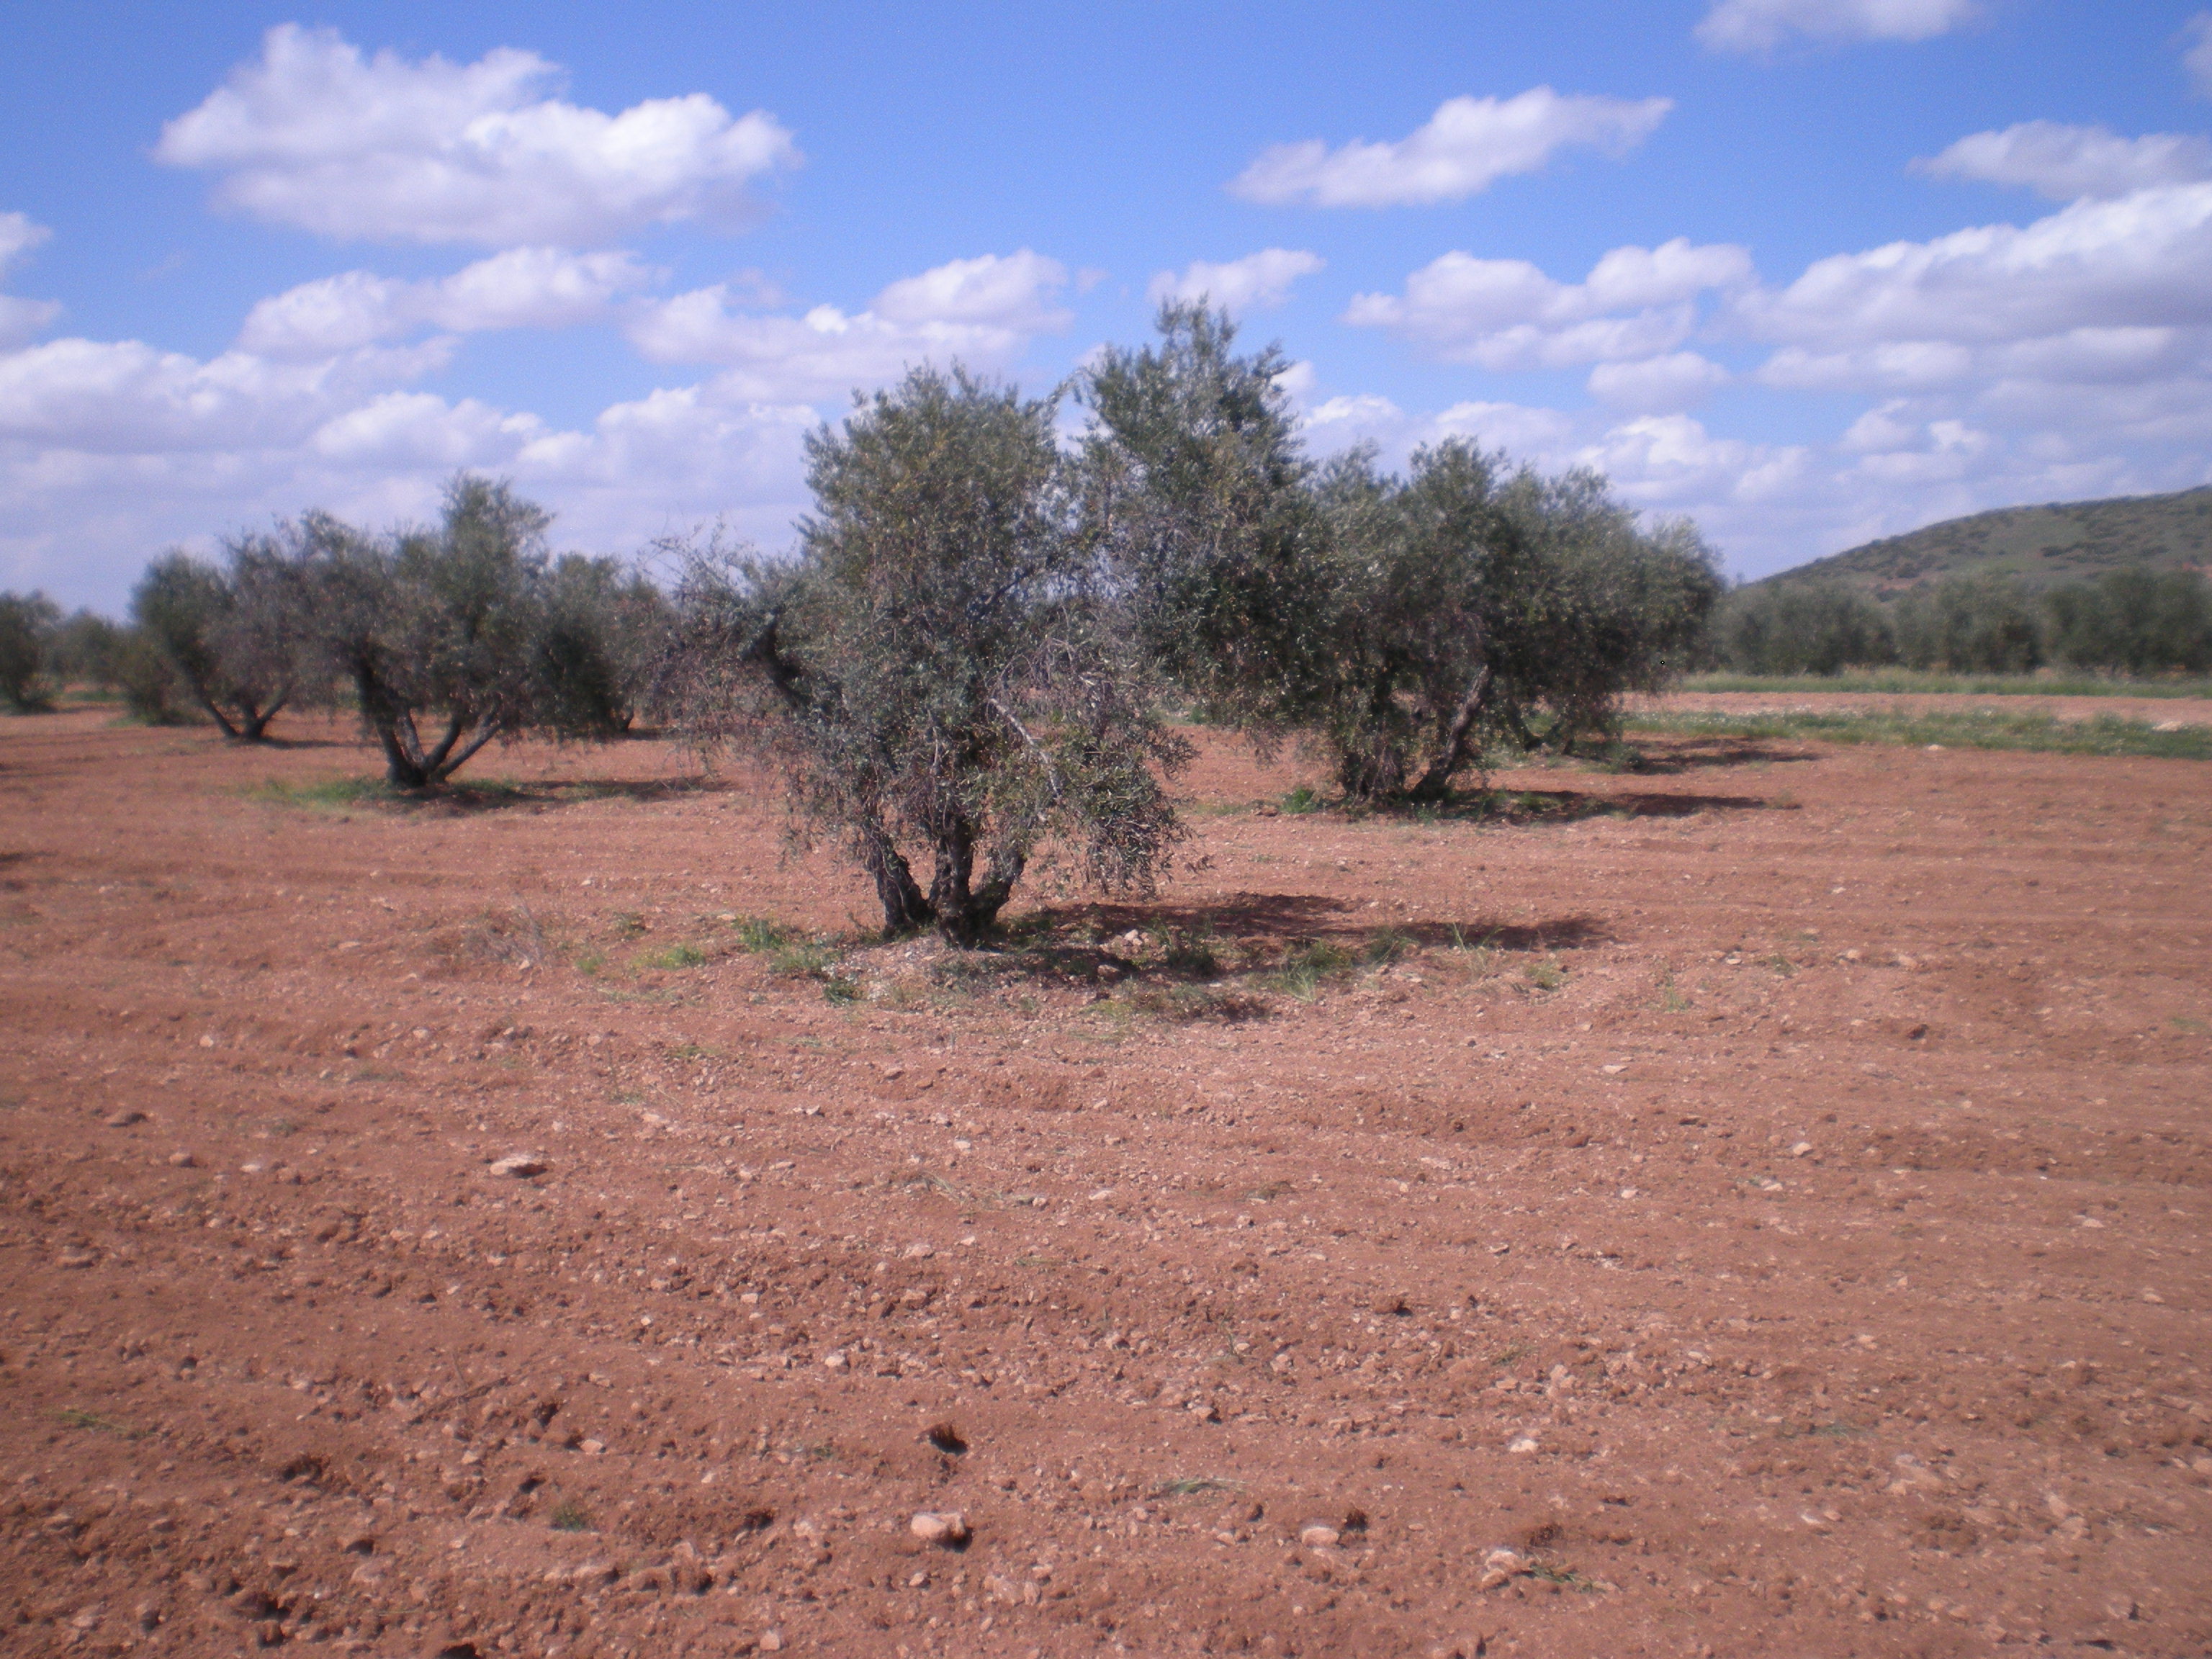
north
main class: Cropland
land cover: Olive groves
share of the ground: 10 - 25 %
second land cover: Other bare soil
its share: > 75 %
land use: Agriculture (excluding fallow land and kitchen gardens)
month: April
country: ES
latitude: 38.6676
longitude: -3.5154
